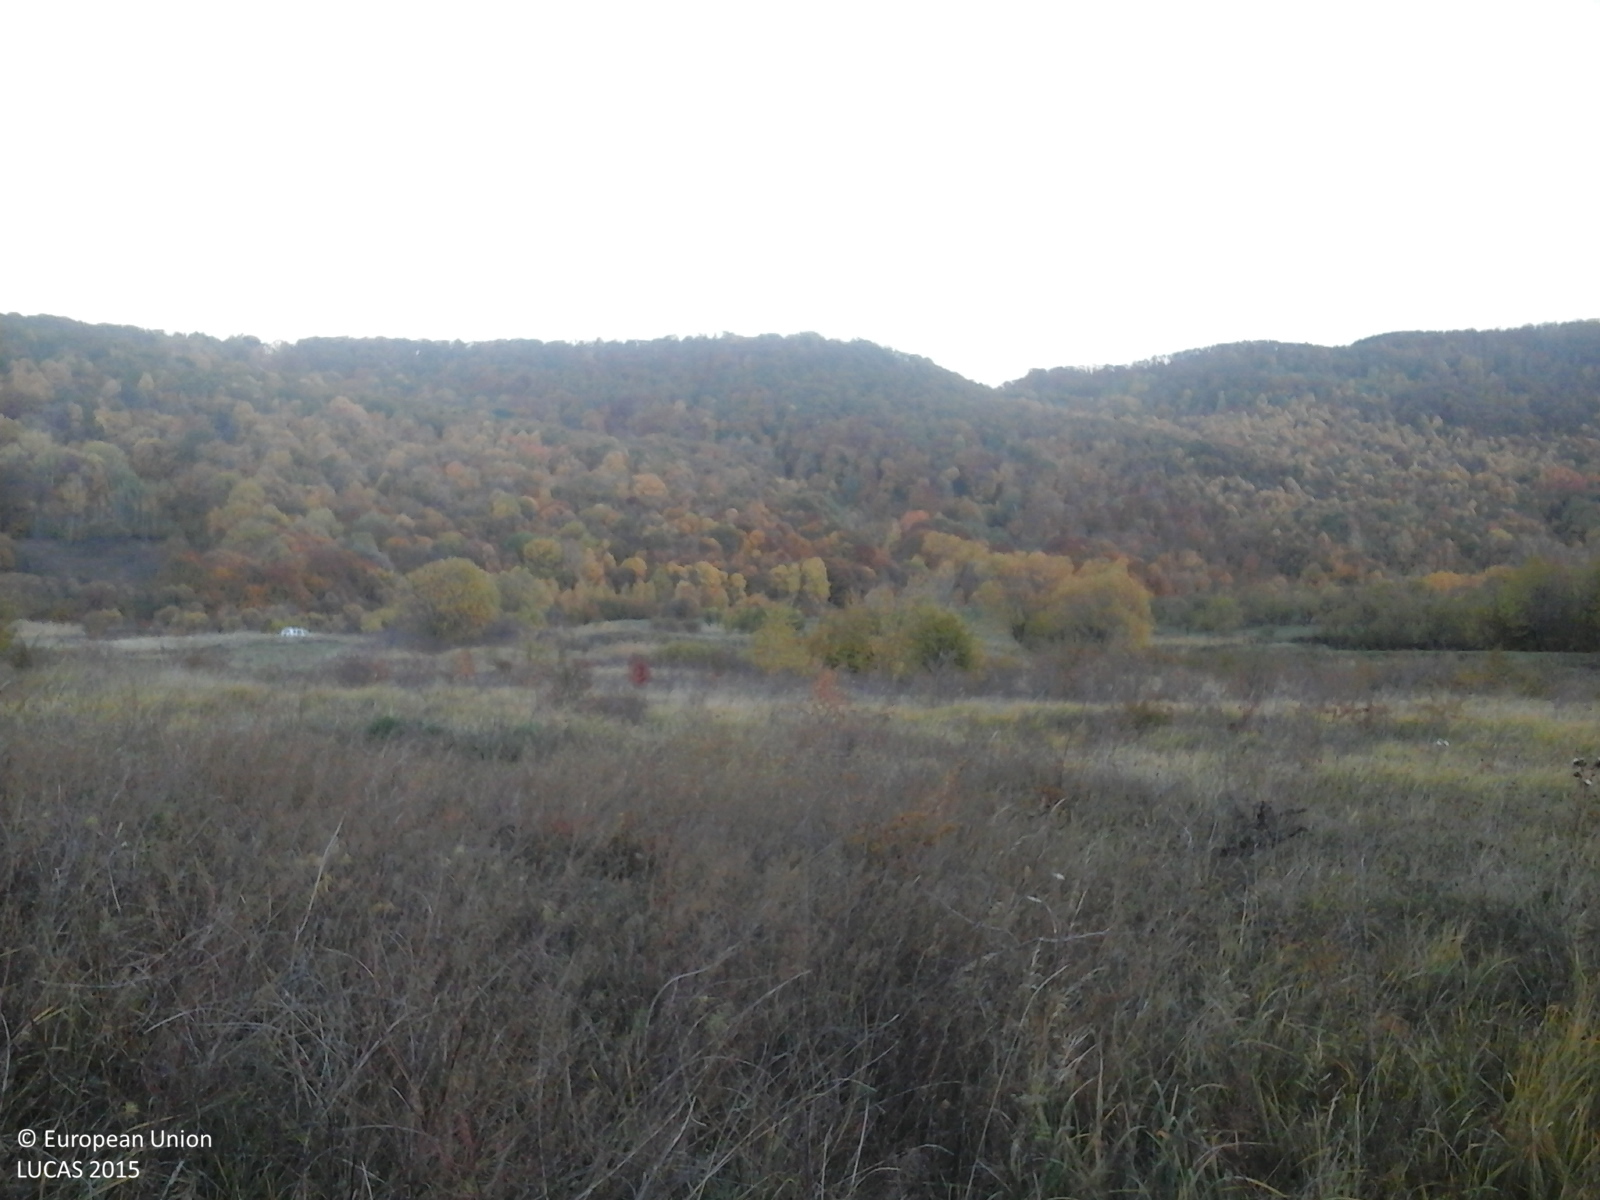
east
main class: Grassland
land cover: Grassland with sparse tree/shrub cover
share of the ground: > 75 %
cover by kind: herbaceous plants 85 %, shrubs 10 %, broadleaved forest trees 5 %
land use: Agriculture (excluding fallow land and kitchen gardens)
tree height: < 5 m
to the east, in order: Grassland with sparse tree/shrub cover; Shrubland with sparse tree cover; Grassland with sparse tree/shrub cover; Spontaneously vegetated surfaces; Single bushes/trees; Tracks; Grassland without tree/shrub cover
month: October
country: RO
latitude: 45.5154
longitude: 26.9719
